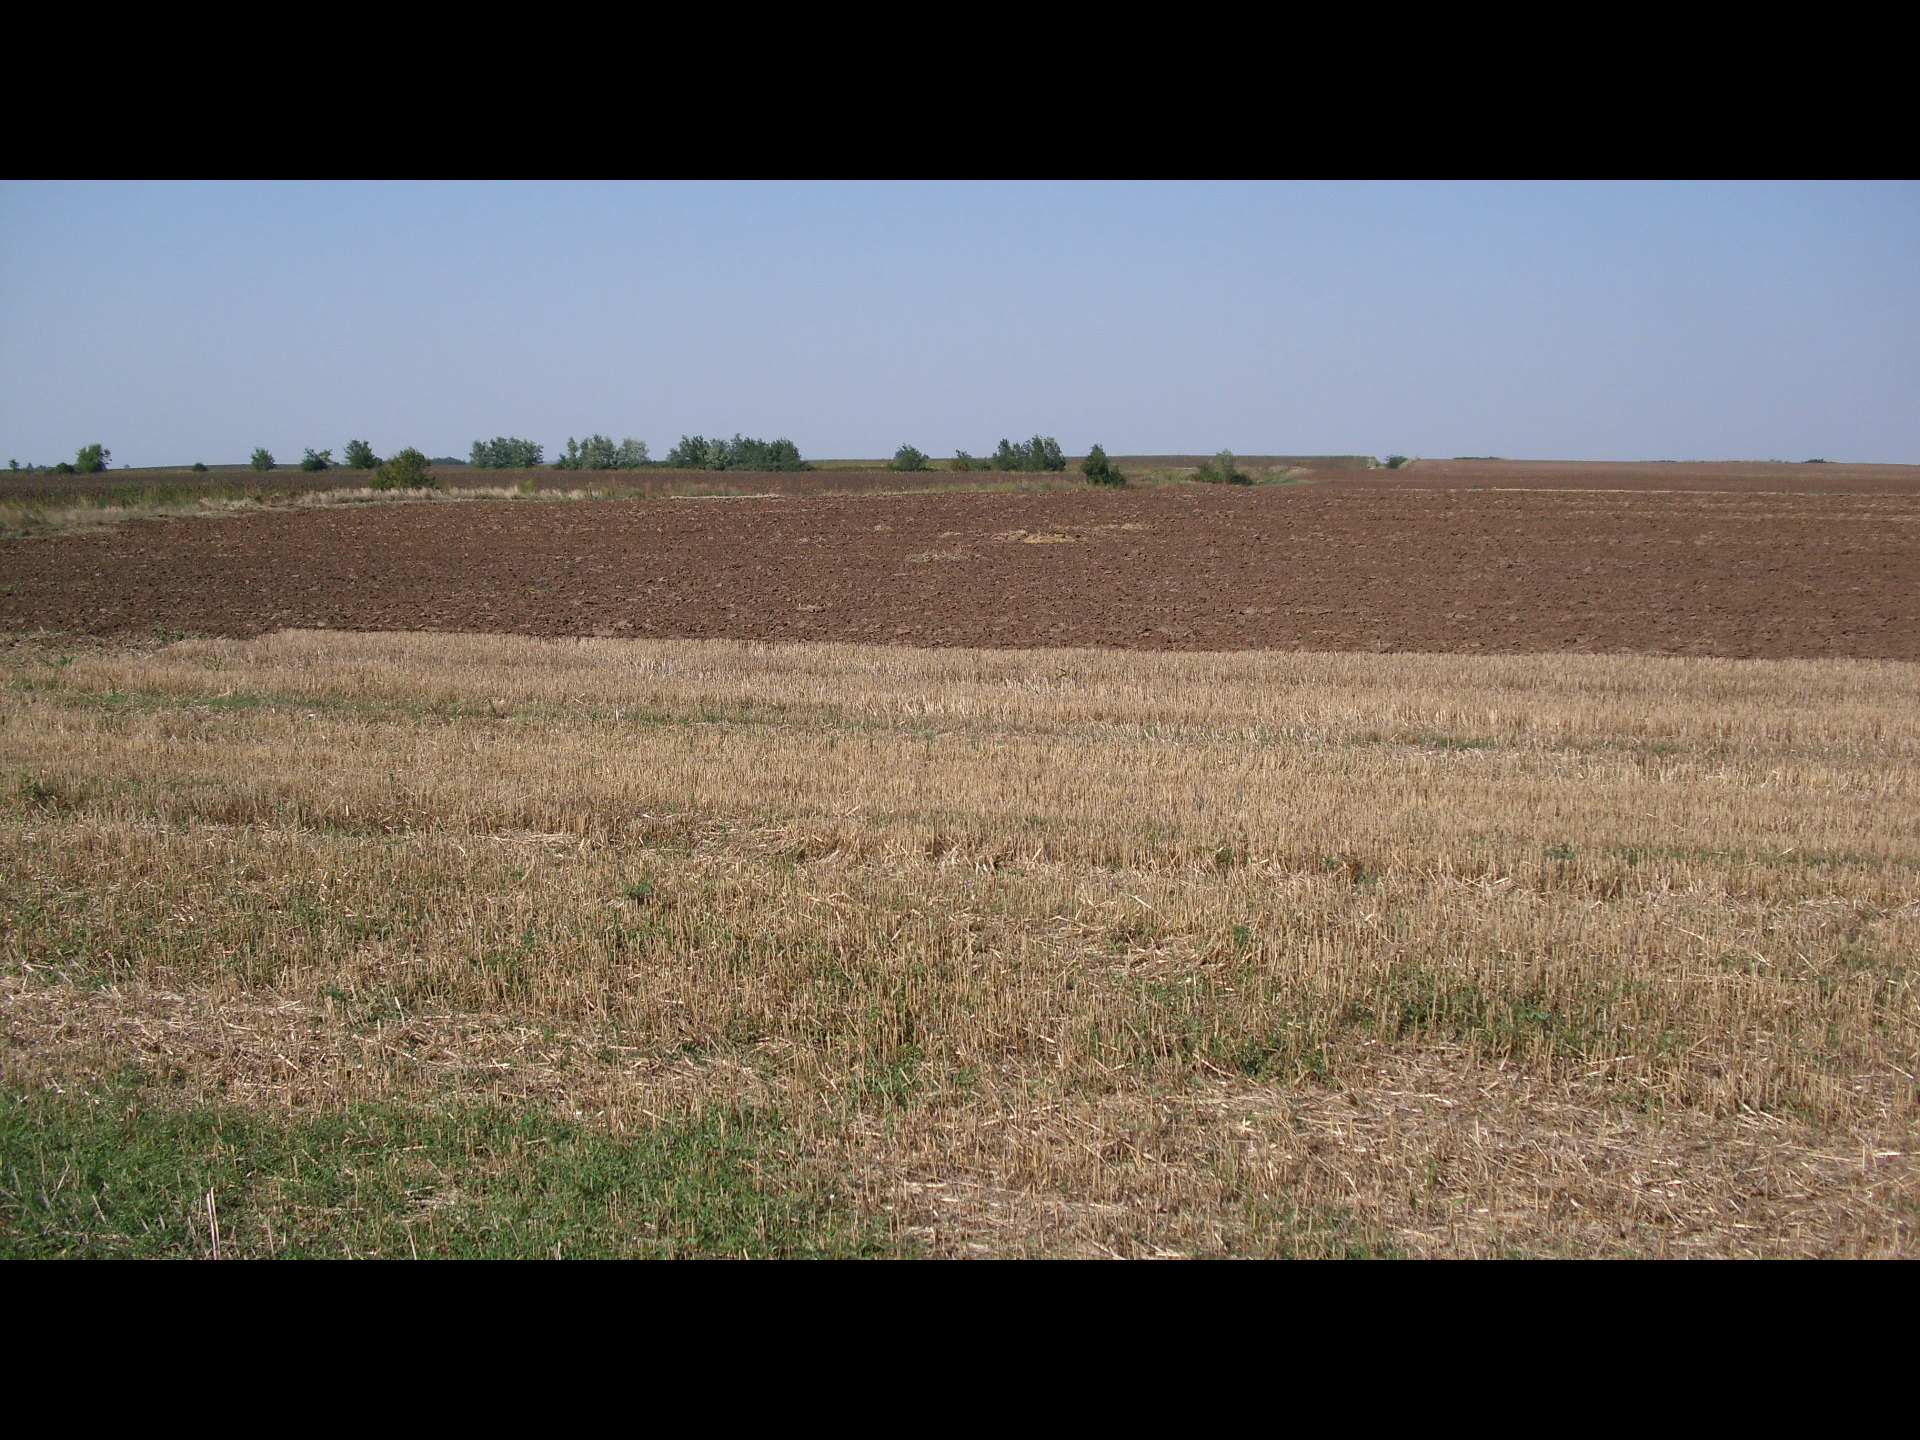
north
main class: Cropland
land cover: Common wheat
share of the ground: 50 - 75 %
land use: Agriculture (excluding fallow land and kitchen gardens)
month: August
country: BG
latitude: 44.1500
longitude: 22.7034
